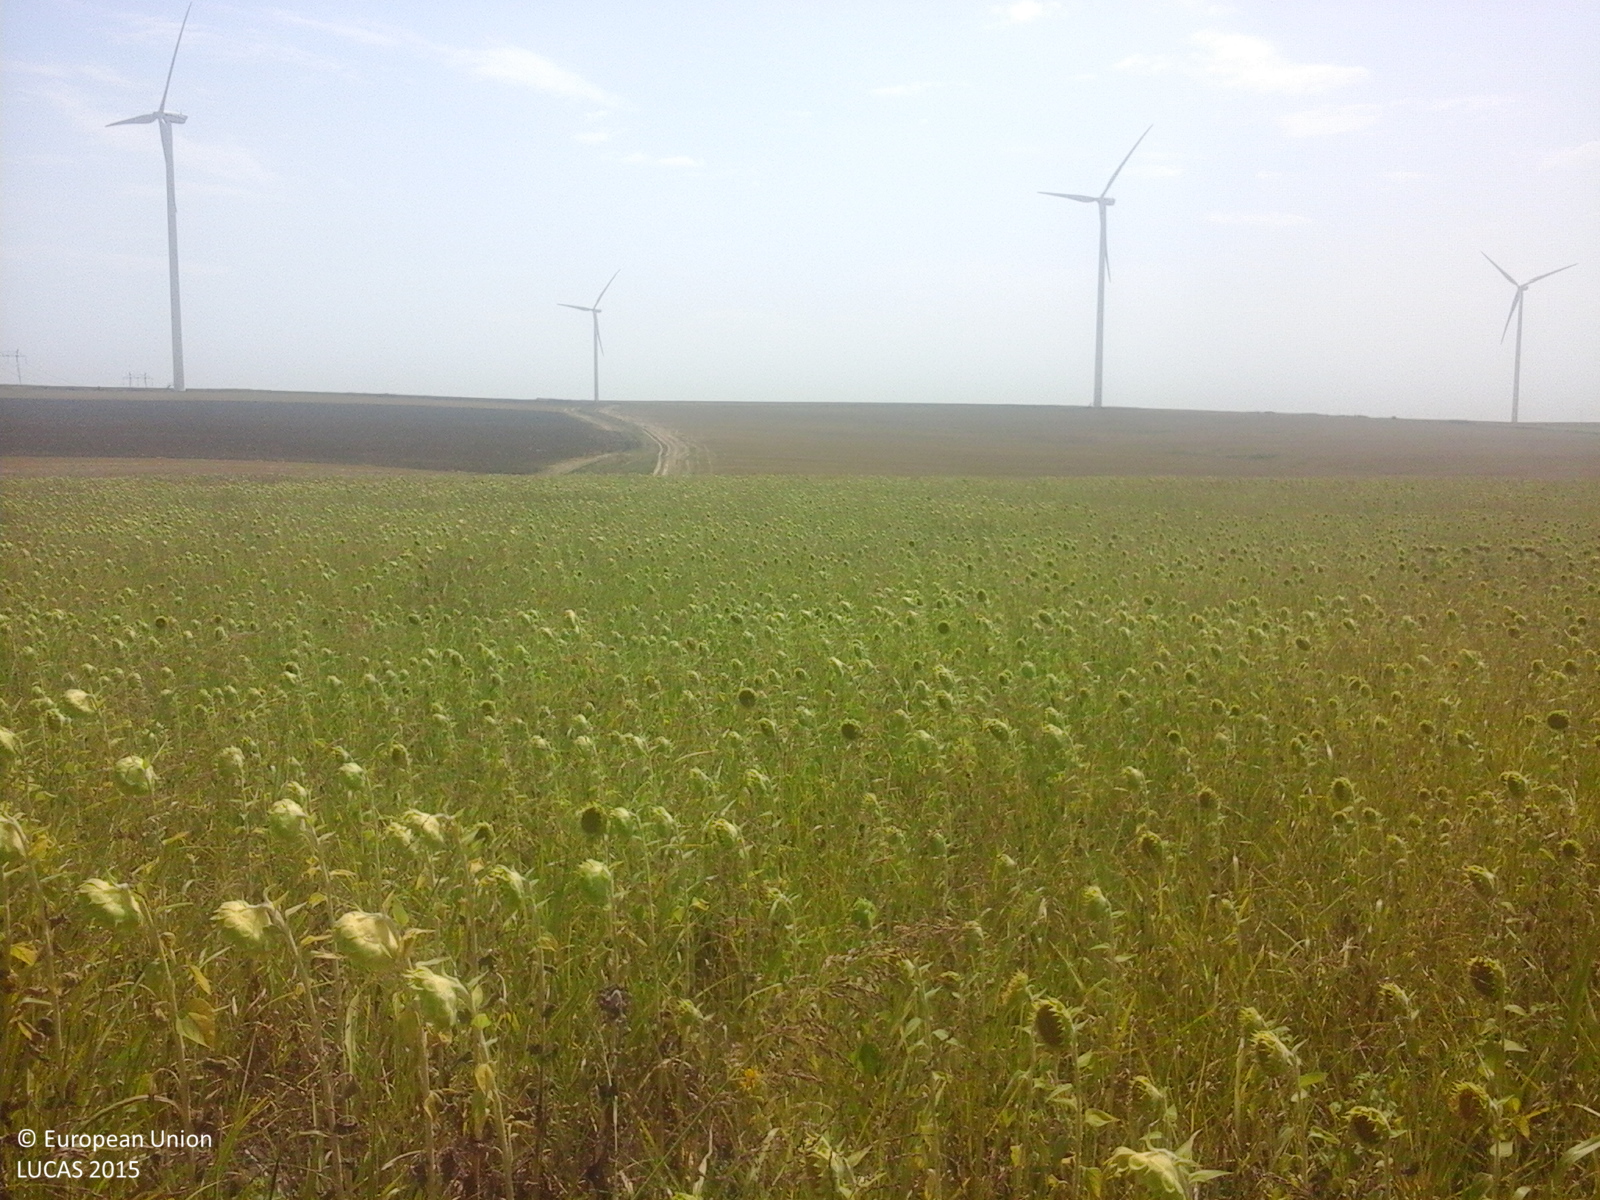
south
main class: Cropland
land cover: Sunflower
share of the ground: > 75 %
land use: Agriculture (excluding fallow land and kitchen gardens)
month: August
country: RO
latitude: 44.3066
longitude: 28.1229
